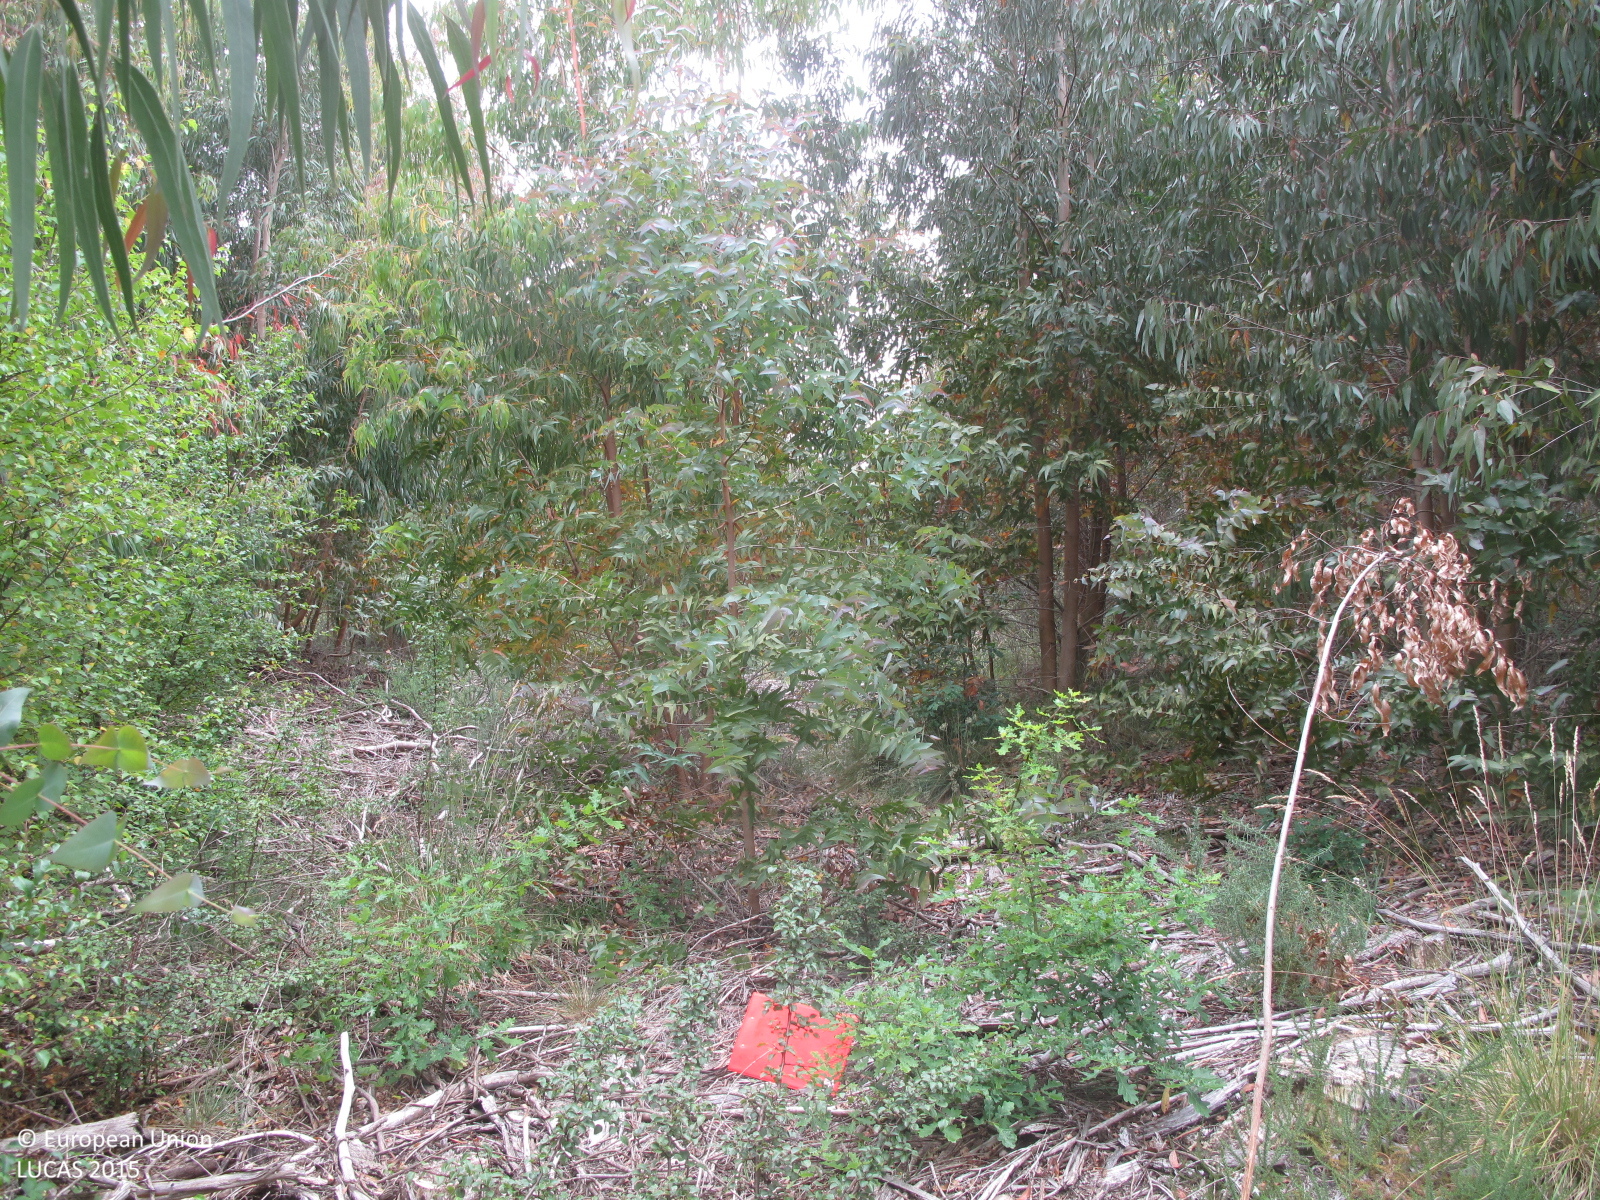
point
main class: Woodland
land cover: Broadleaved woodland
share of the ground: 50 - 75 %
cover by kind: broadleaved forest trees 70 %, shrubs 10 %, herbaceous plants 10 %, unconsolidated bare surface 10 %
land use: Forestry
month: June
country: ES
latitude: 43.1643
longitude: -8.1142
